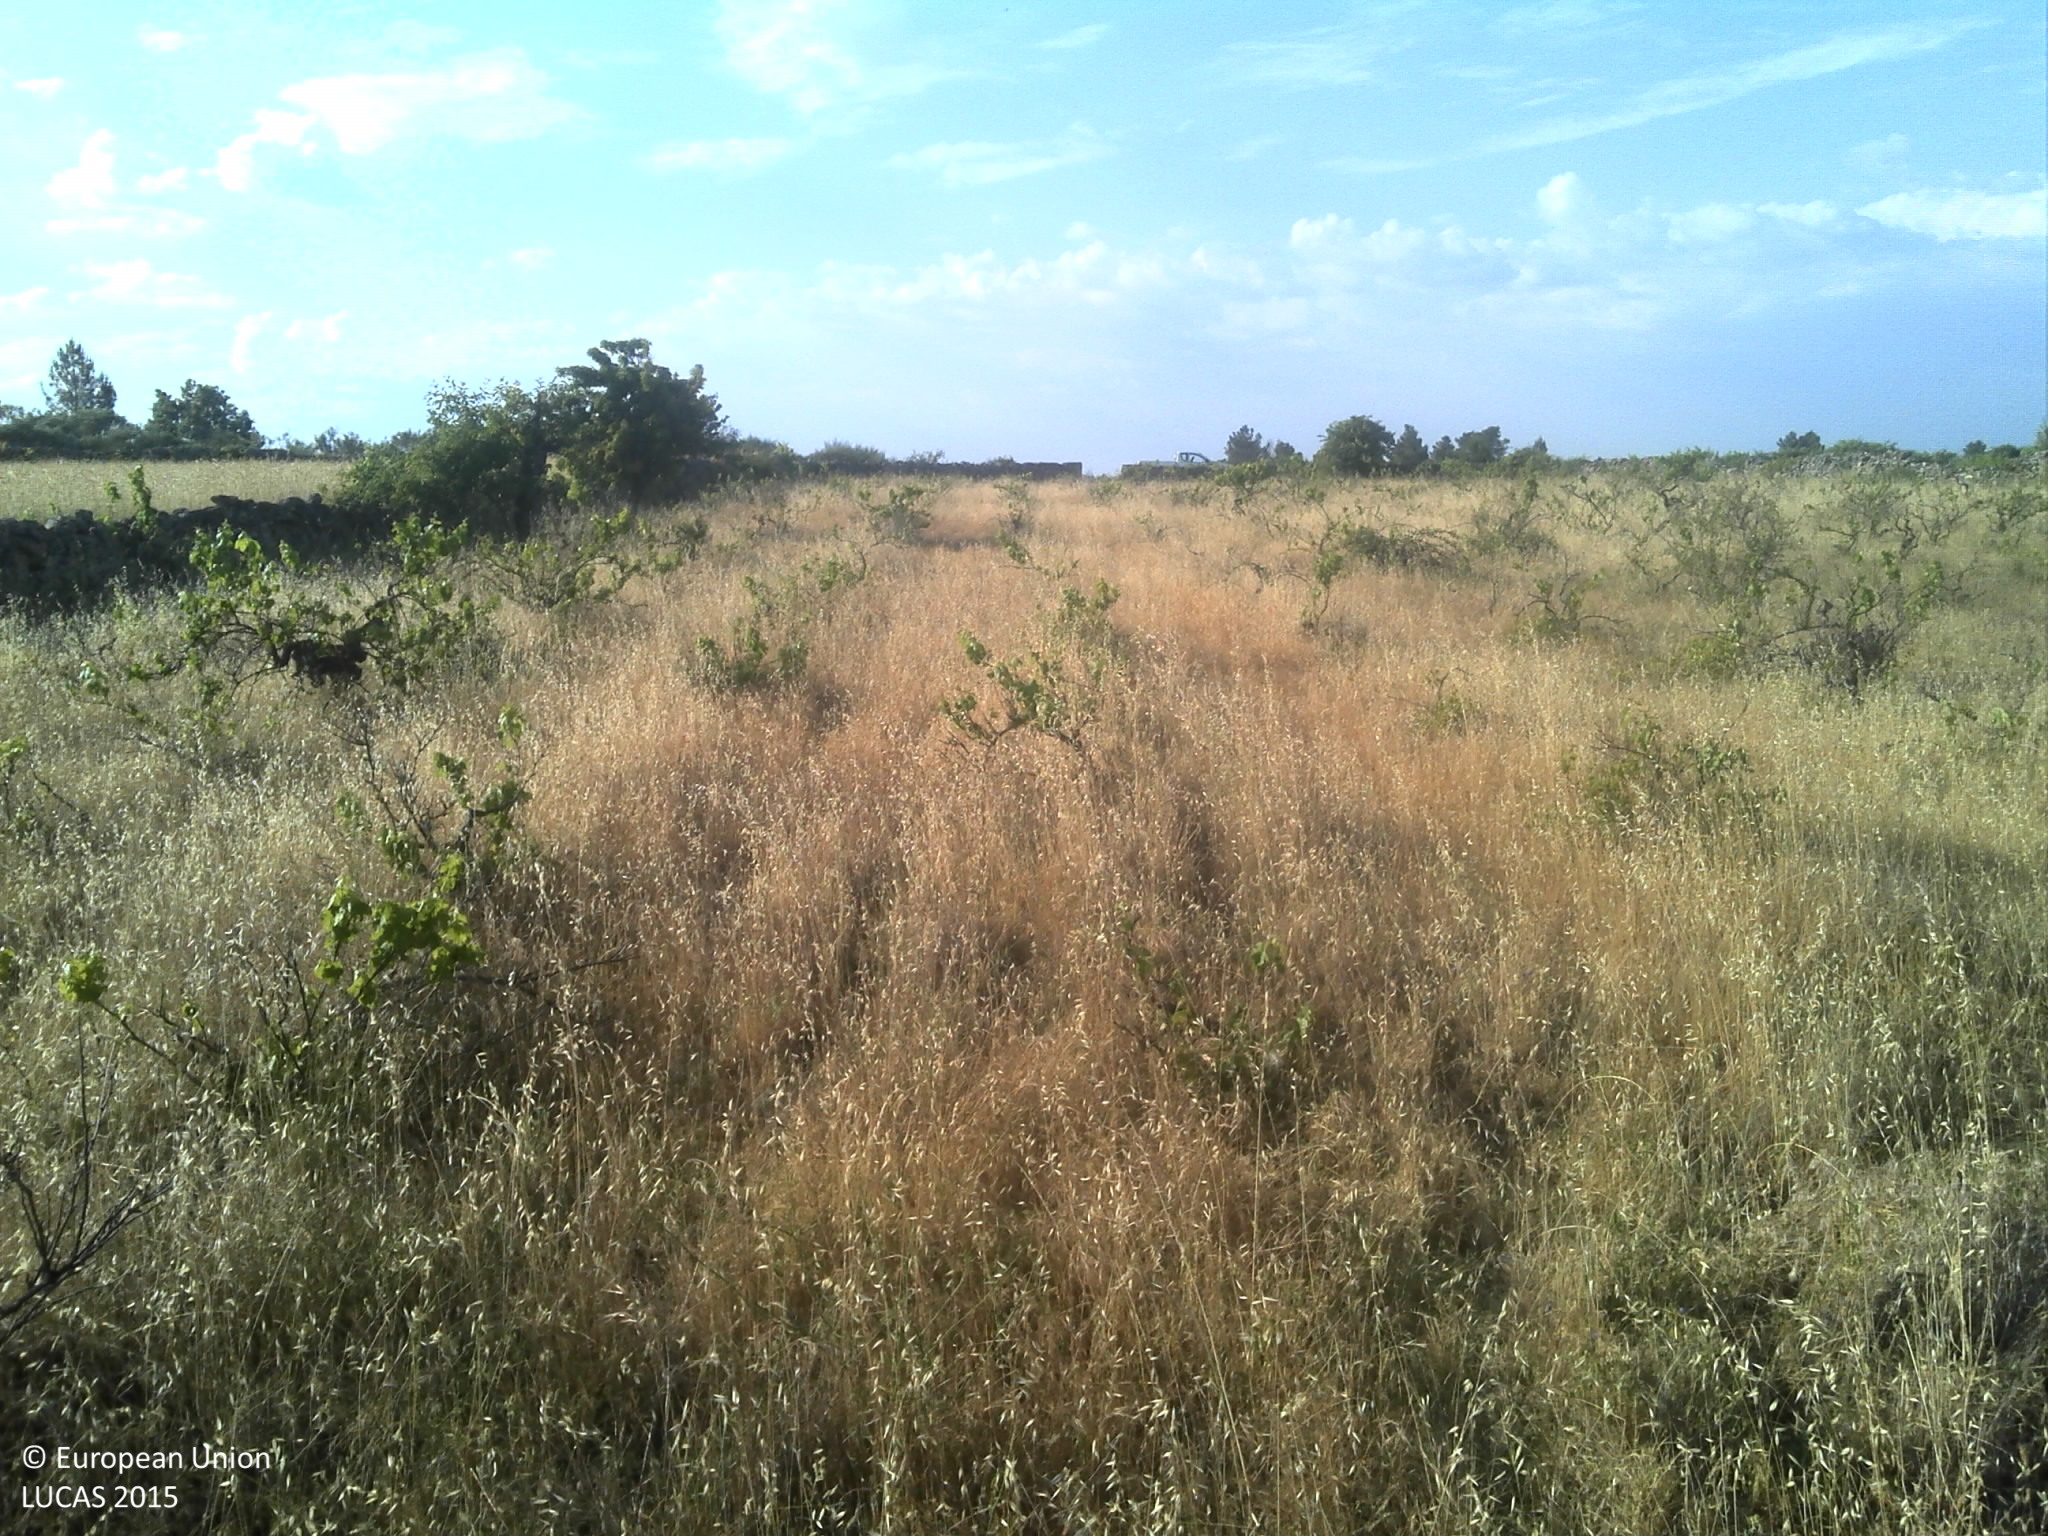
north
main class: Cropland
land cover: Vineyards
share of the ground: 10 - 25 %
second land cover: Grassland without tree/shrub cover
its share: 50 - 75 %
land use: Agriculture (excluding fallow land and kitchen gardens)
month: June
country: PT
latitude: 40.5029
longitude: -7.0089
